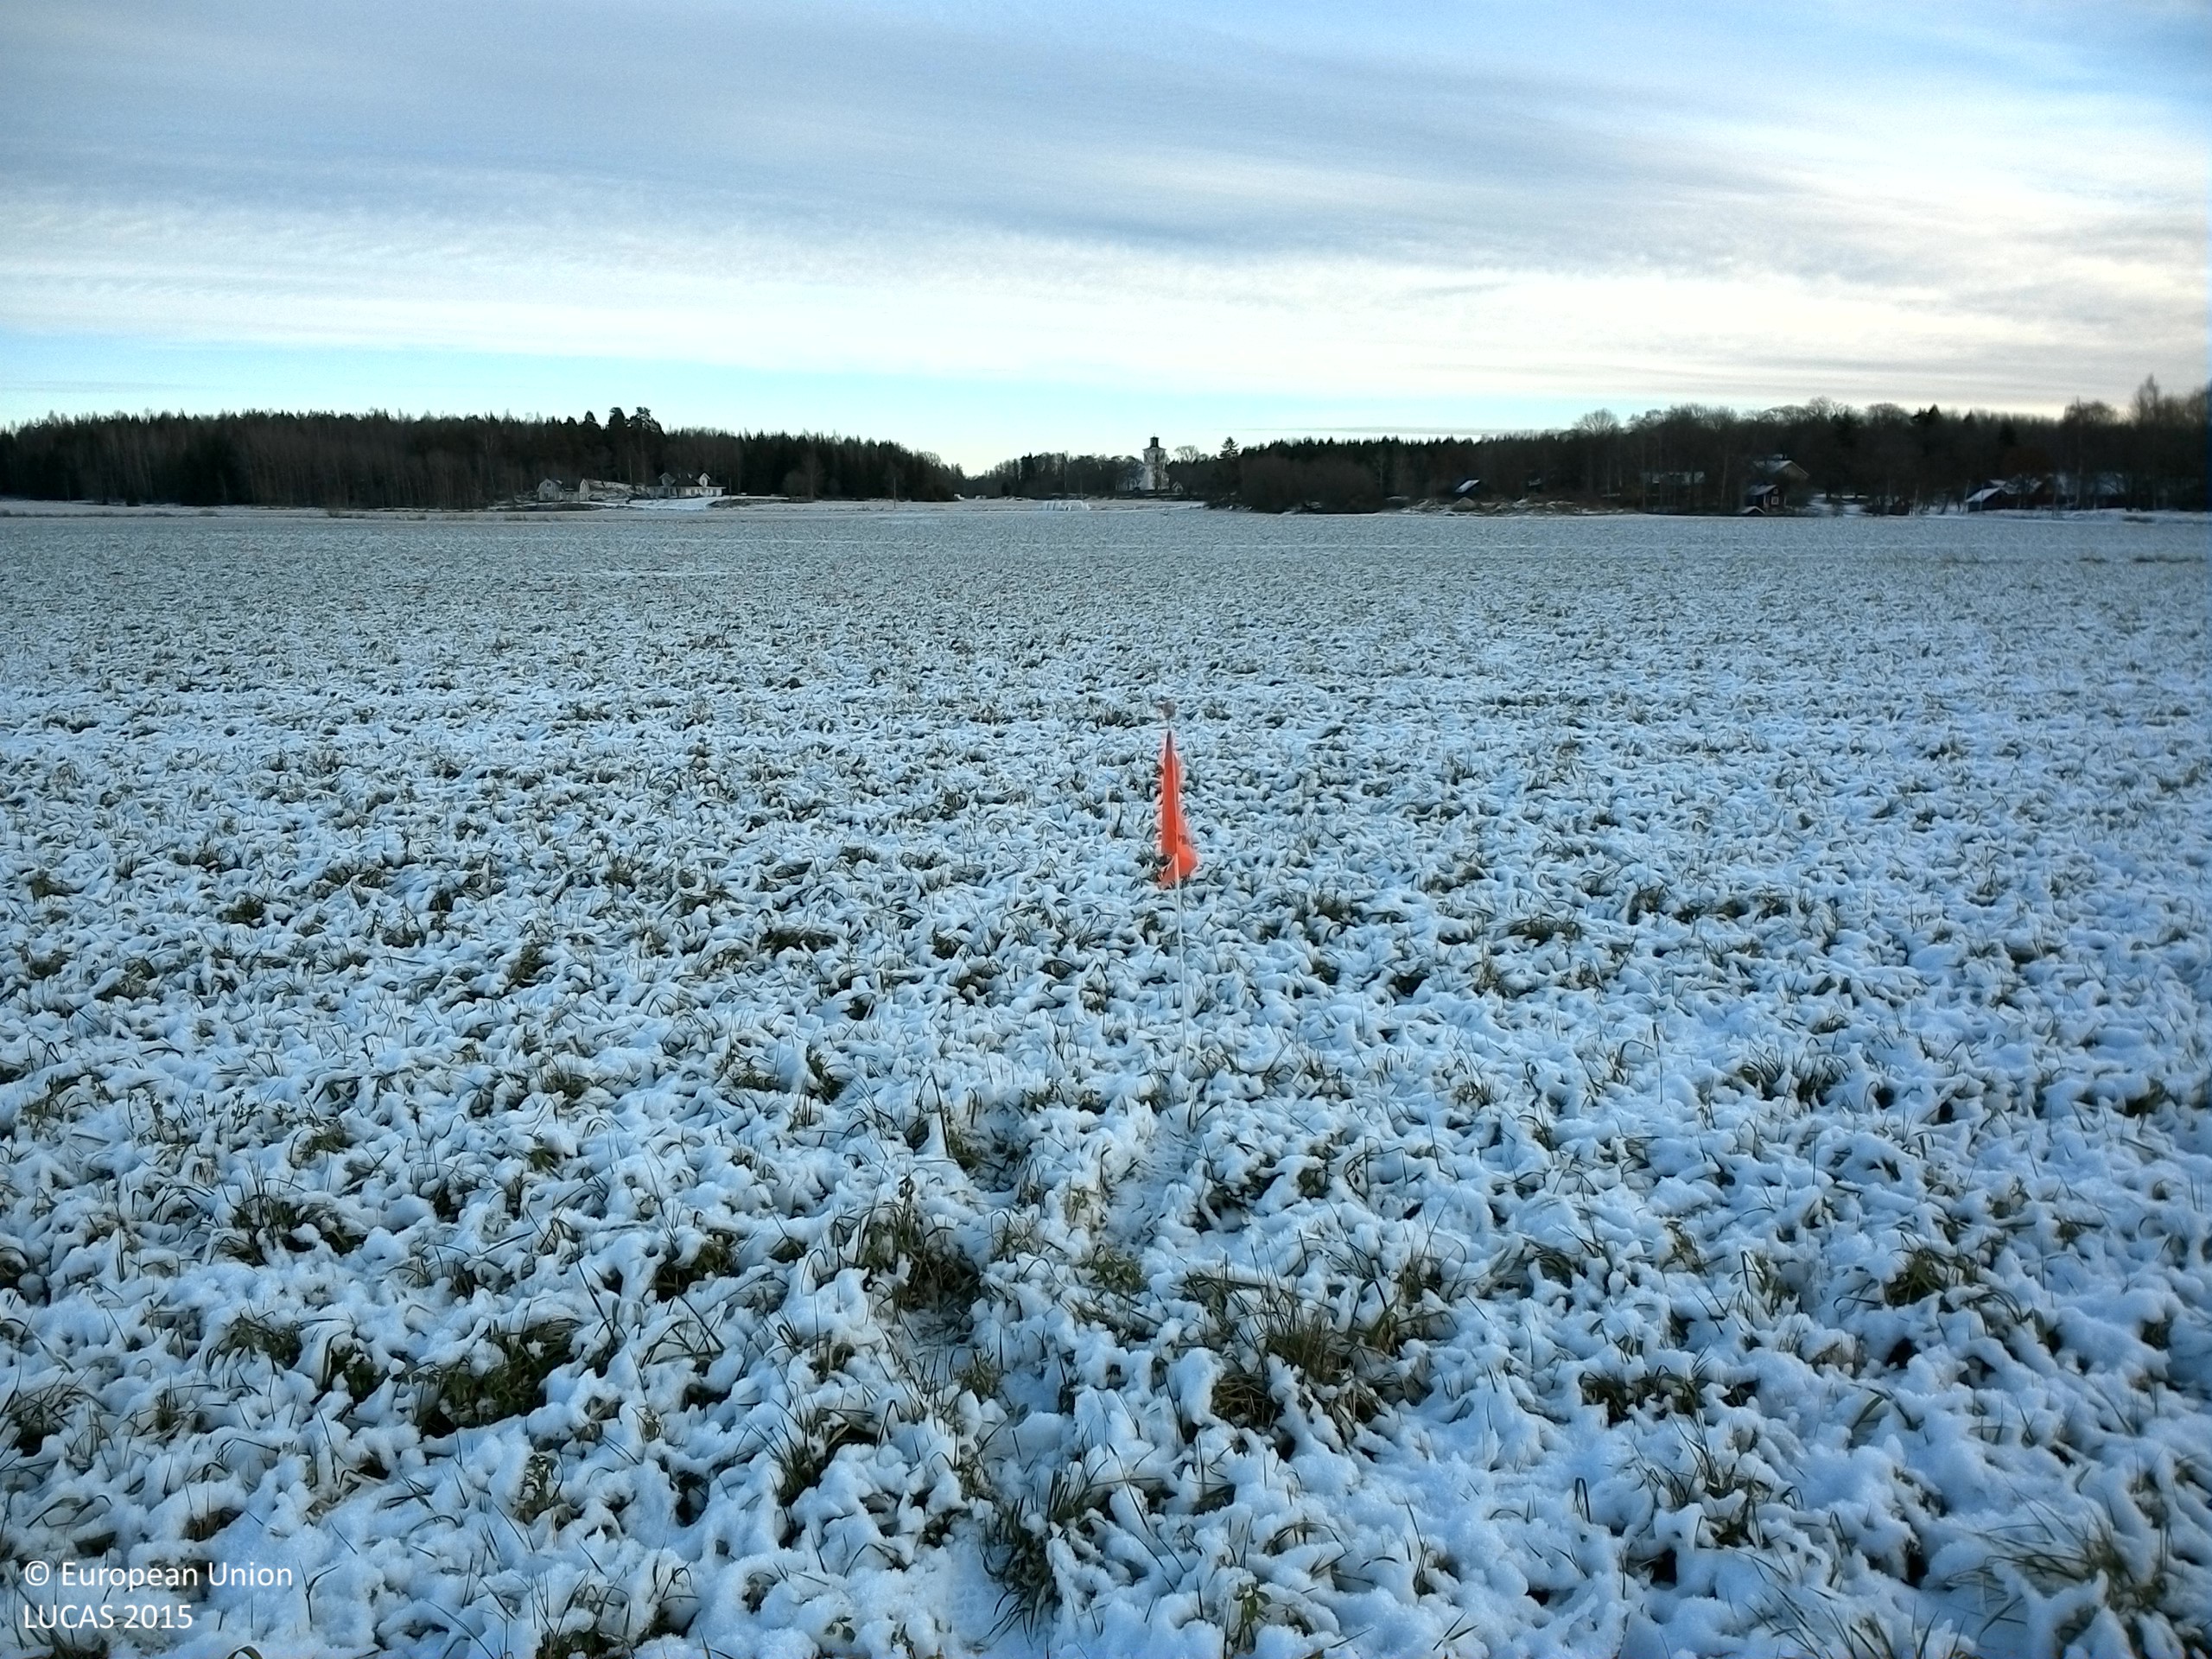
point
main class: Cropland
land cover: Common wheat
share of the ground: > 75 %
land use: Agriculture (excluding fallow land and kitchen gardens)
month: December
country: SE
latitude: 59.4966
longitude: 16.3330
